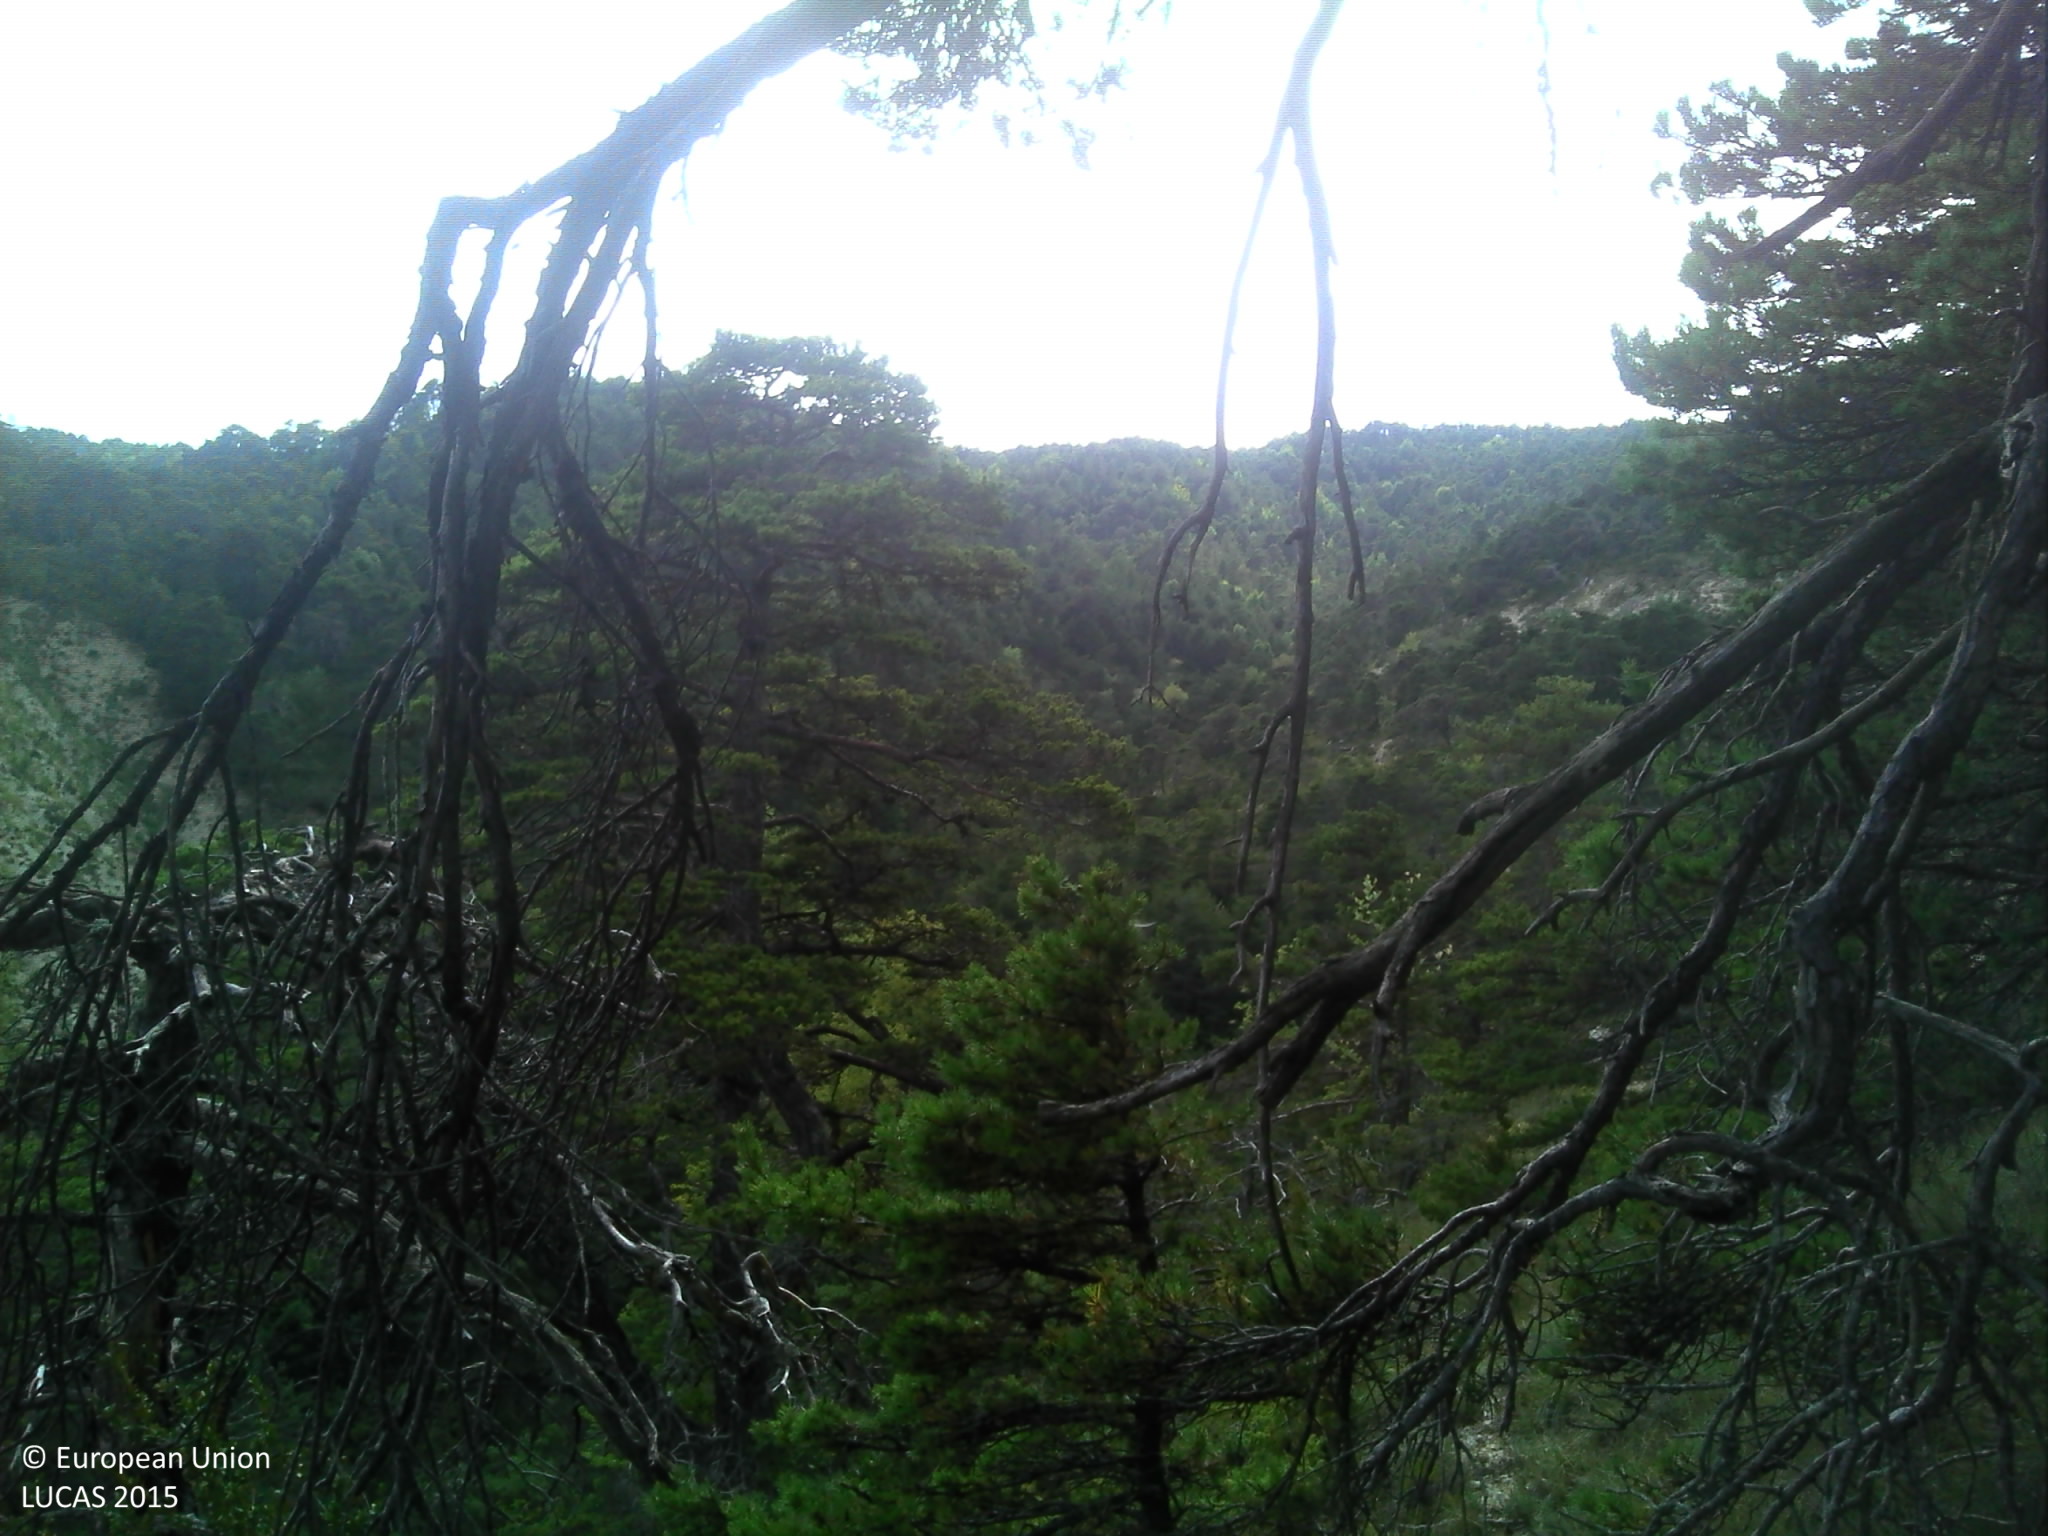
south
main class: Woodland
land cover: Pine dominated coniferous woodland
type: coniferous forest of the mediterranean region
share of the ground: > 75 %
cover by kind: coniferous forest trees 65 %, herbaceous plants 30 %, broadleaved forest trees 5 %
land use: Semi-natural and natural areas not in use
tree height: > 5 m
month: September
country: FR
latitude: 44.5382
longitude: 5.4133
